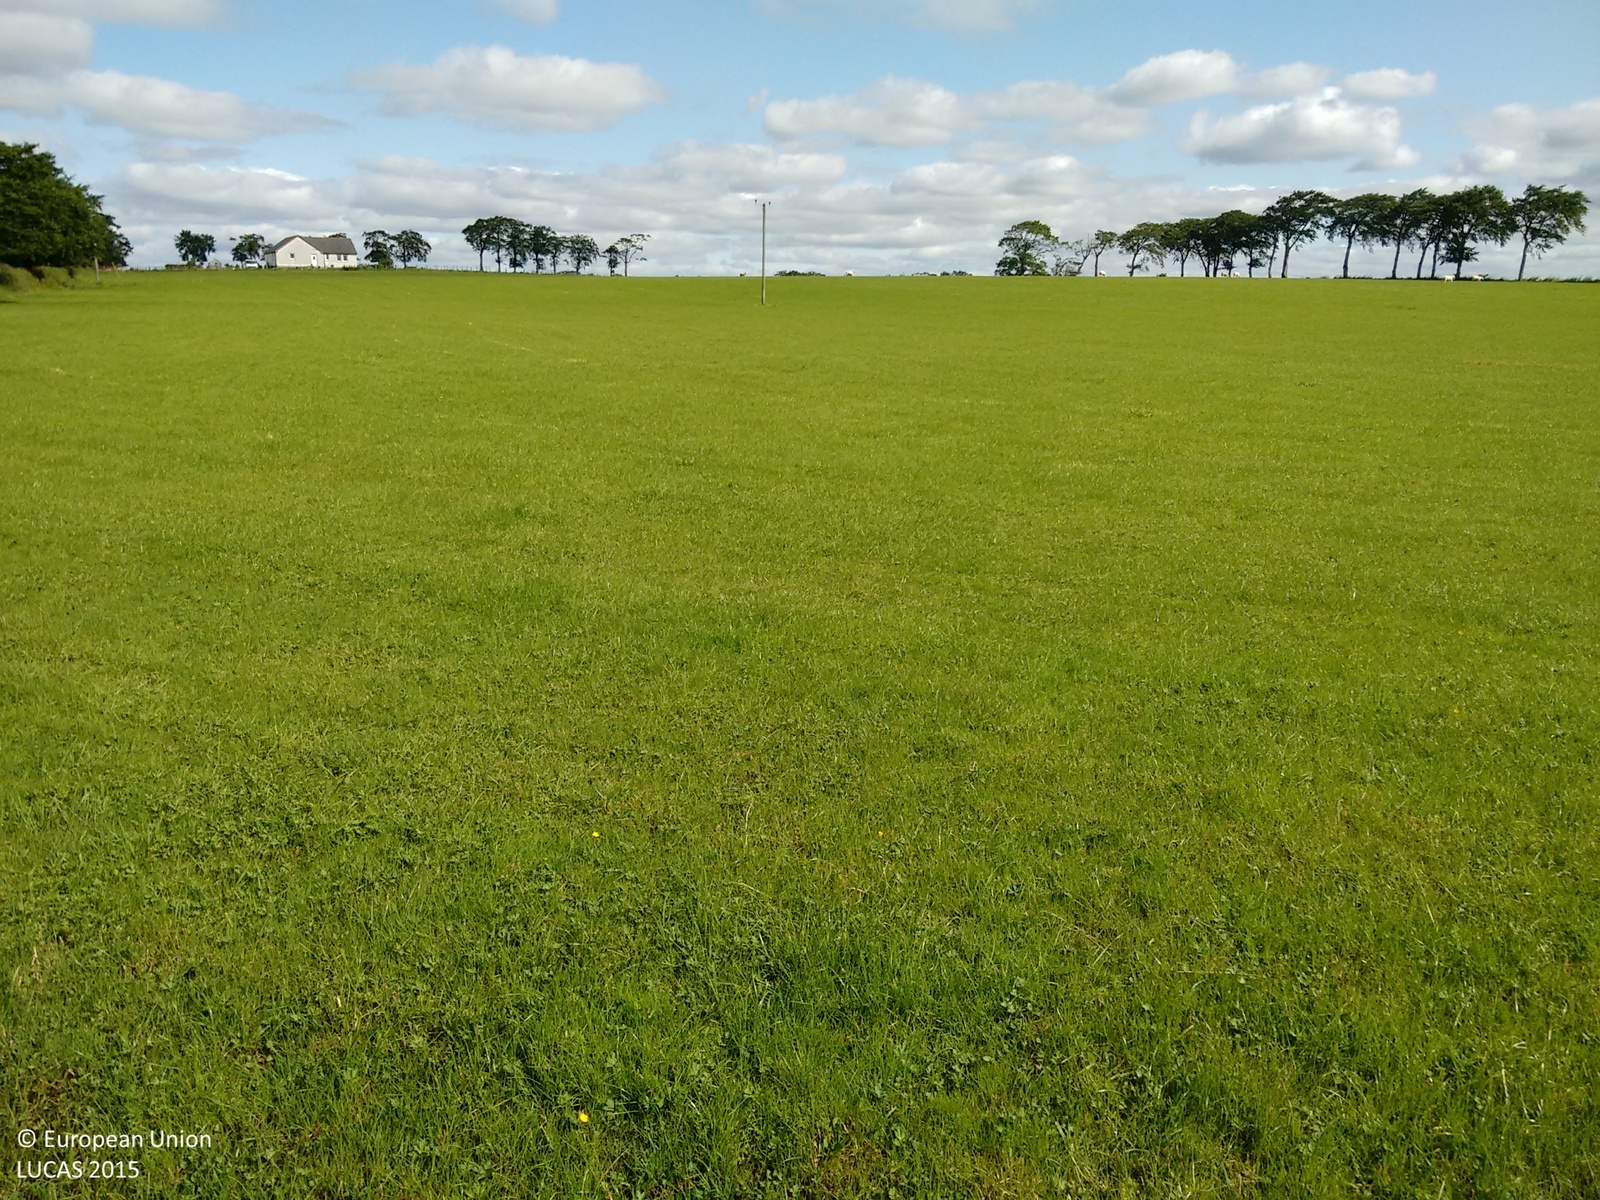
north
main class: Grassland
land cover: Grassland without tree/shrub cover
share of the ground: > 75 %
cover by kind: herbaceous plants 90 %, unconsolidated bare surface 10 %
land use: Agriculture (excluding fallow land and kitchen gardens)
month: July
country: GB
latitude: 55.7271
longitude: -4.1512
